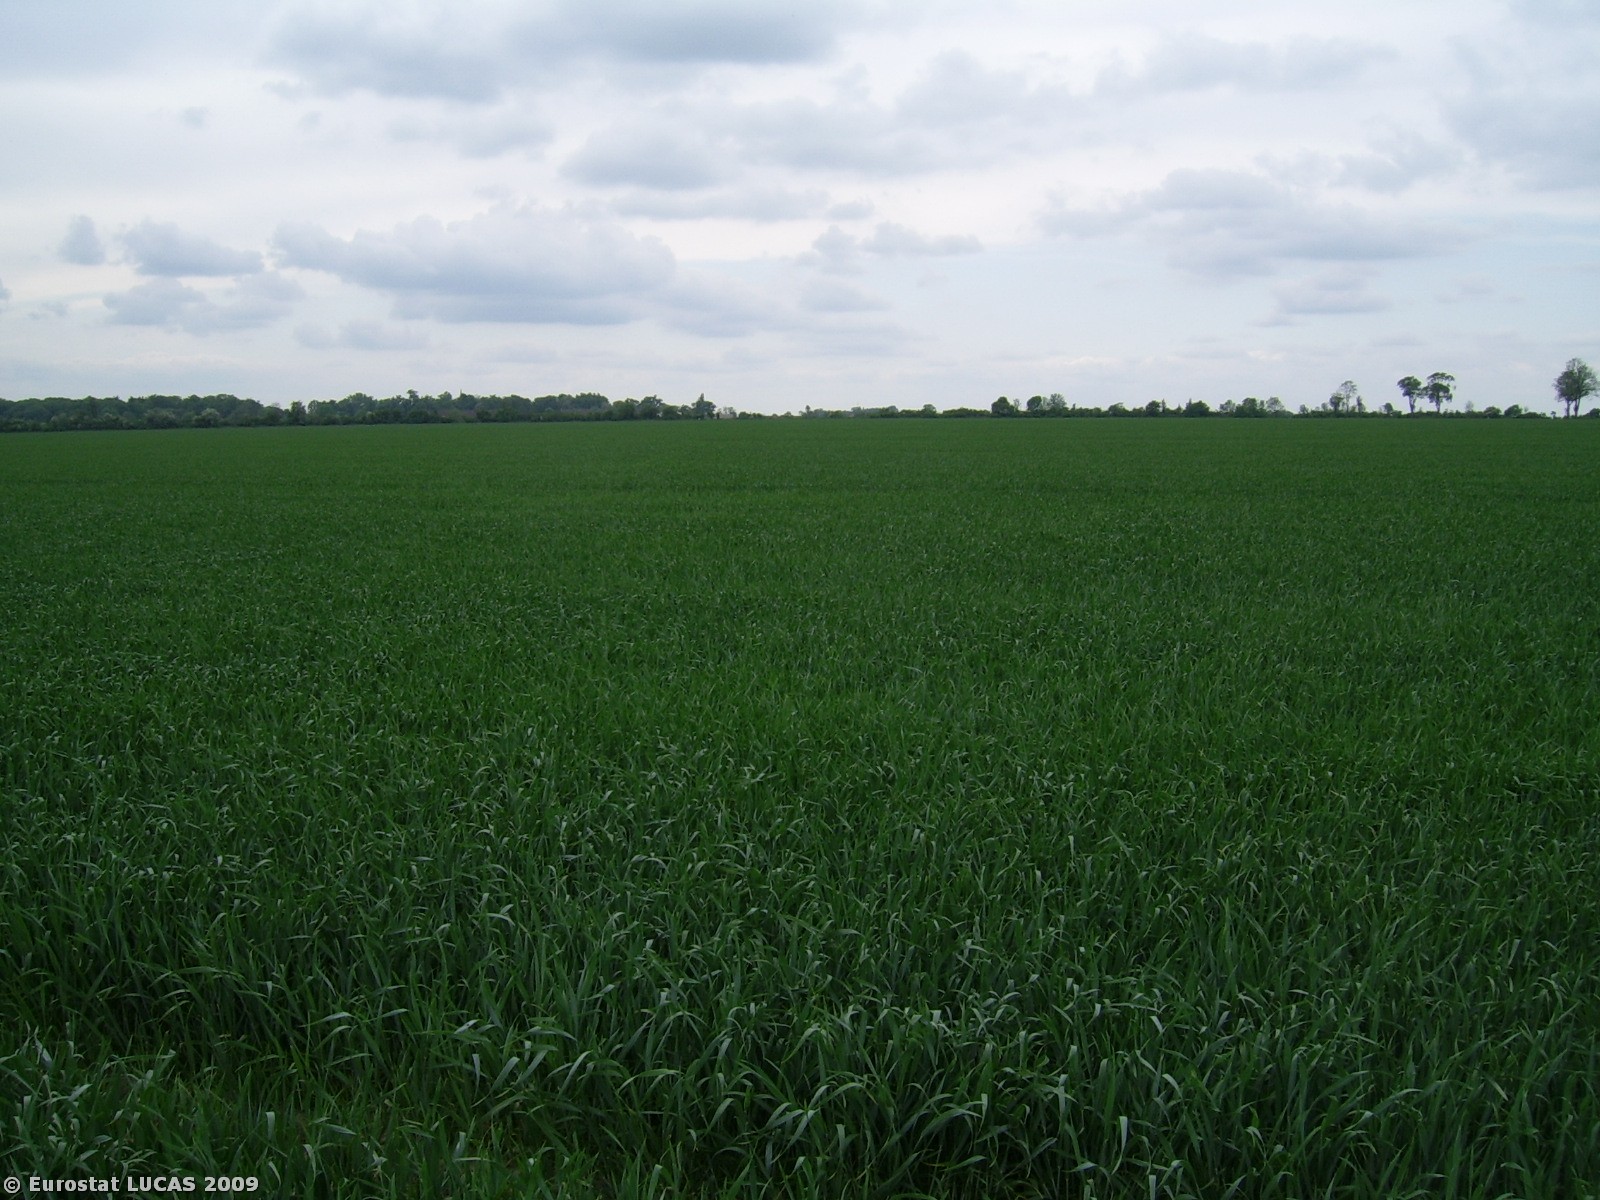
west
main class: Cropland
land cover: Common wheat
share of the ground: > 75 %
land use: Agriculture (excluding fallow land and kitchen gardens)
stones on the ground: < 10 %
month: May
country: PL
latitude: 51.8175
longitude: 16.8711
